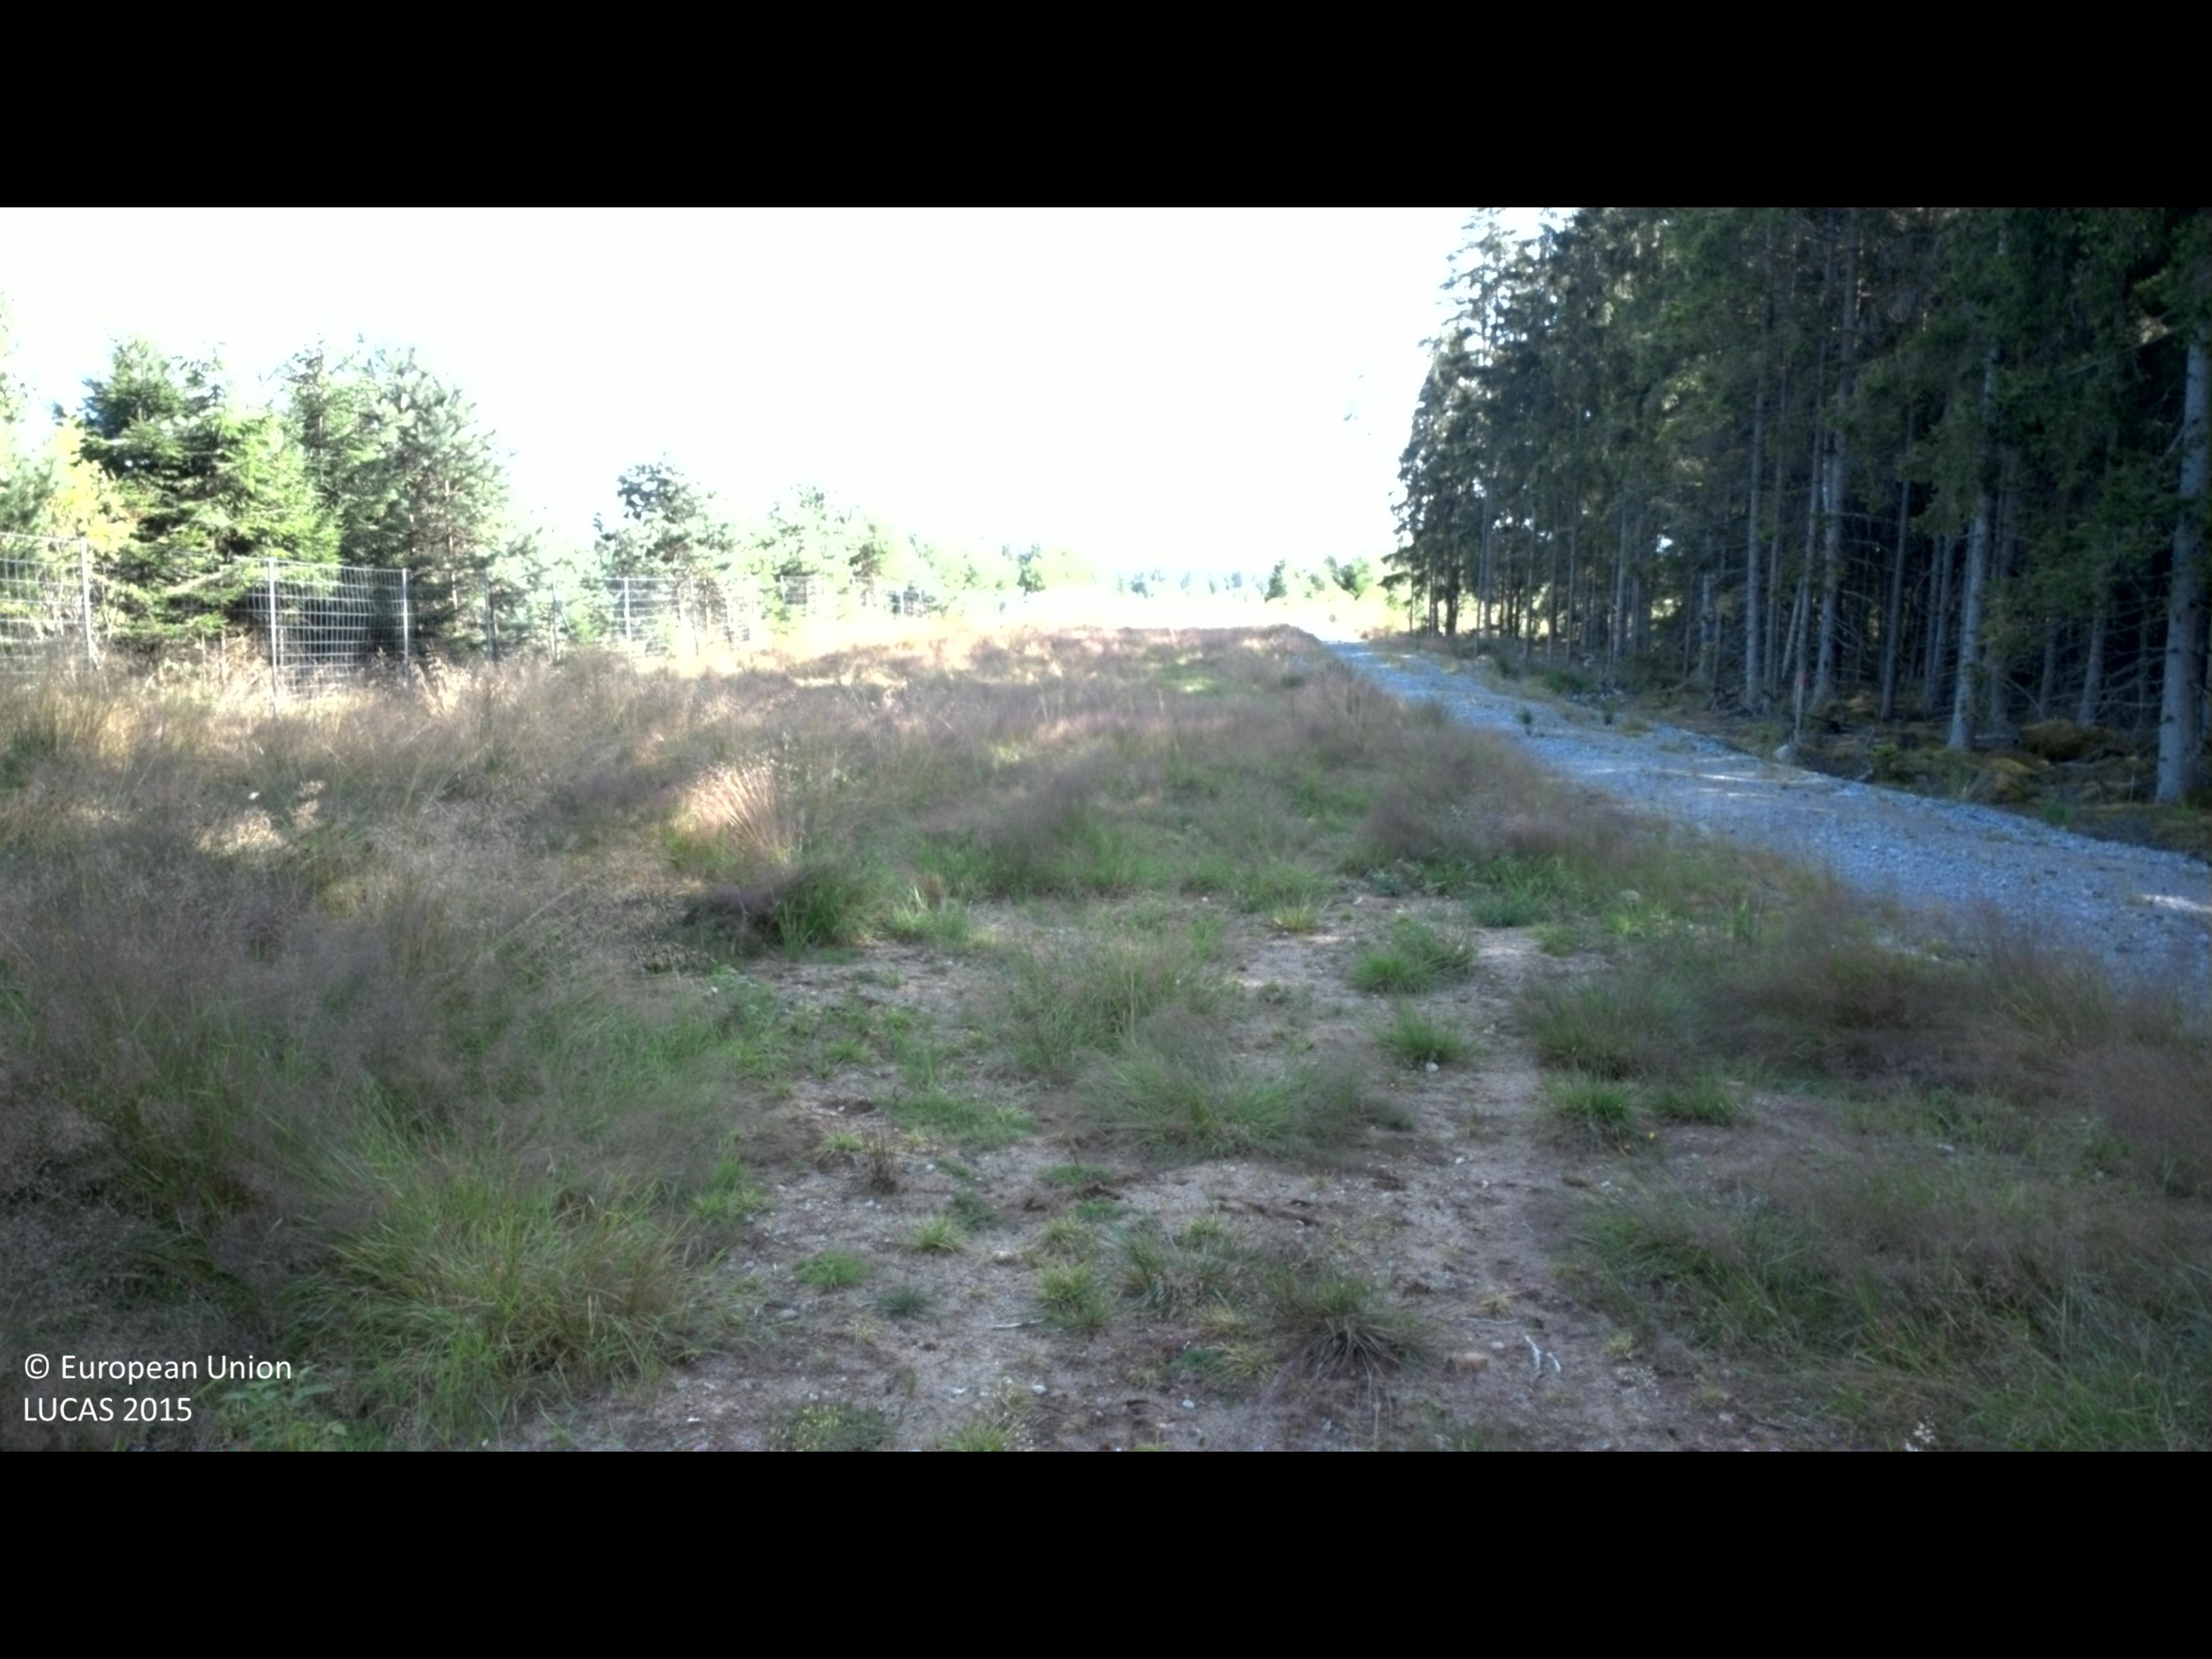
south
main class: Grassland
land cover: Grassland without tree/shrub cover
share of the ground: > 75 %
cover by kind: herbaceous plants 90 %, unconsolidated bare surface 10 %
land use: Forestry
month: August
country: SE
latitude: 56.6885
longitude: 13.8335
